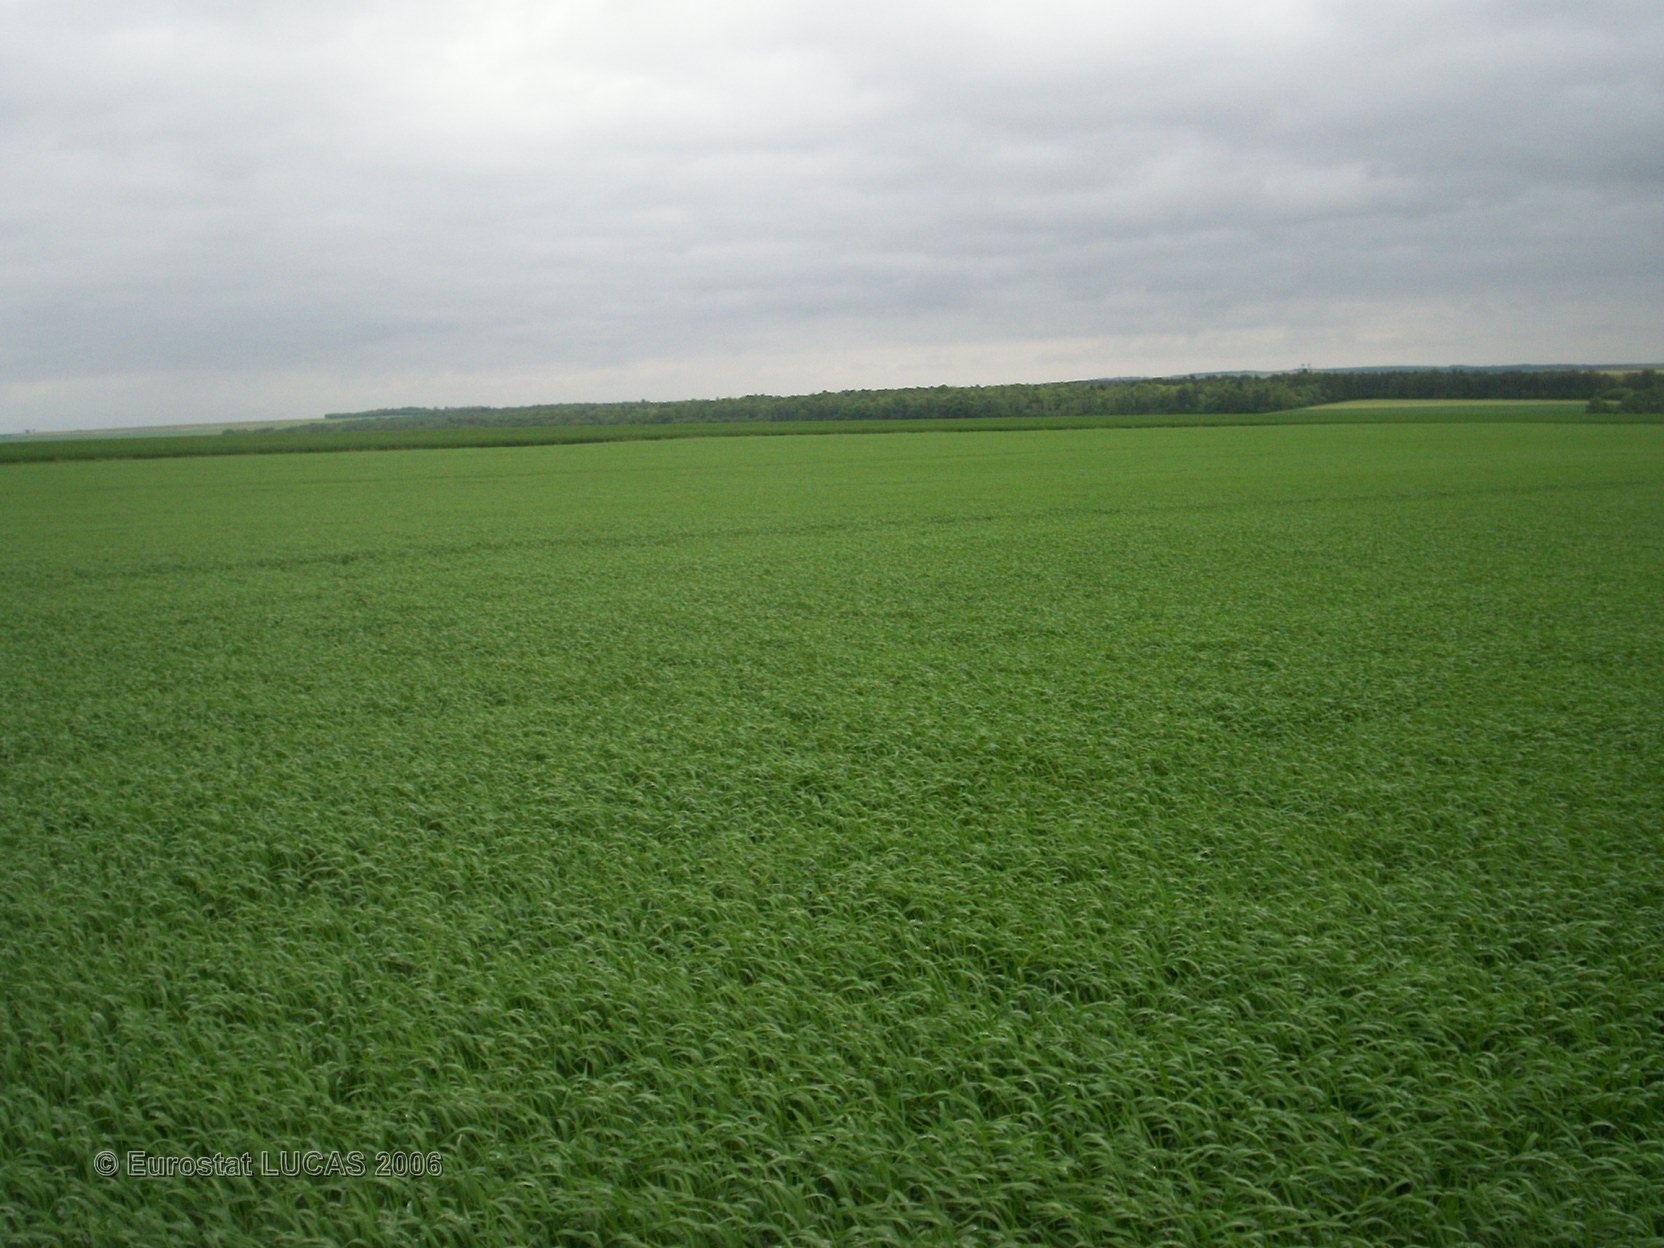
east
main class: Cropland
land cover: Barley
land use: Agriculture (excluding fallow land and kitchen gardens)
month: May
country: FR
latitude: 49.3267
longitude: 4.4236
